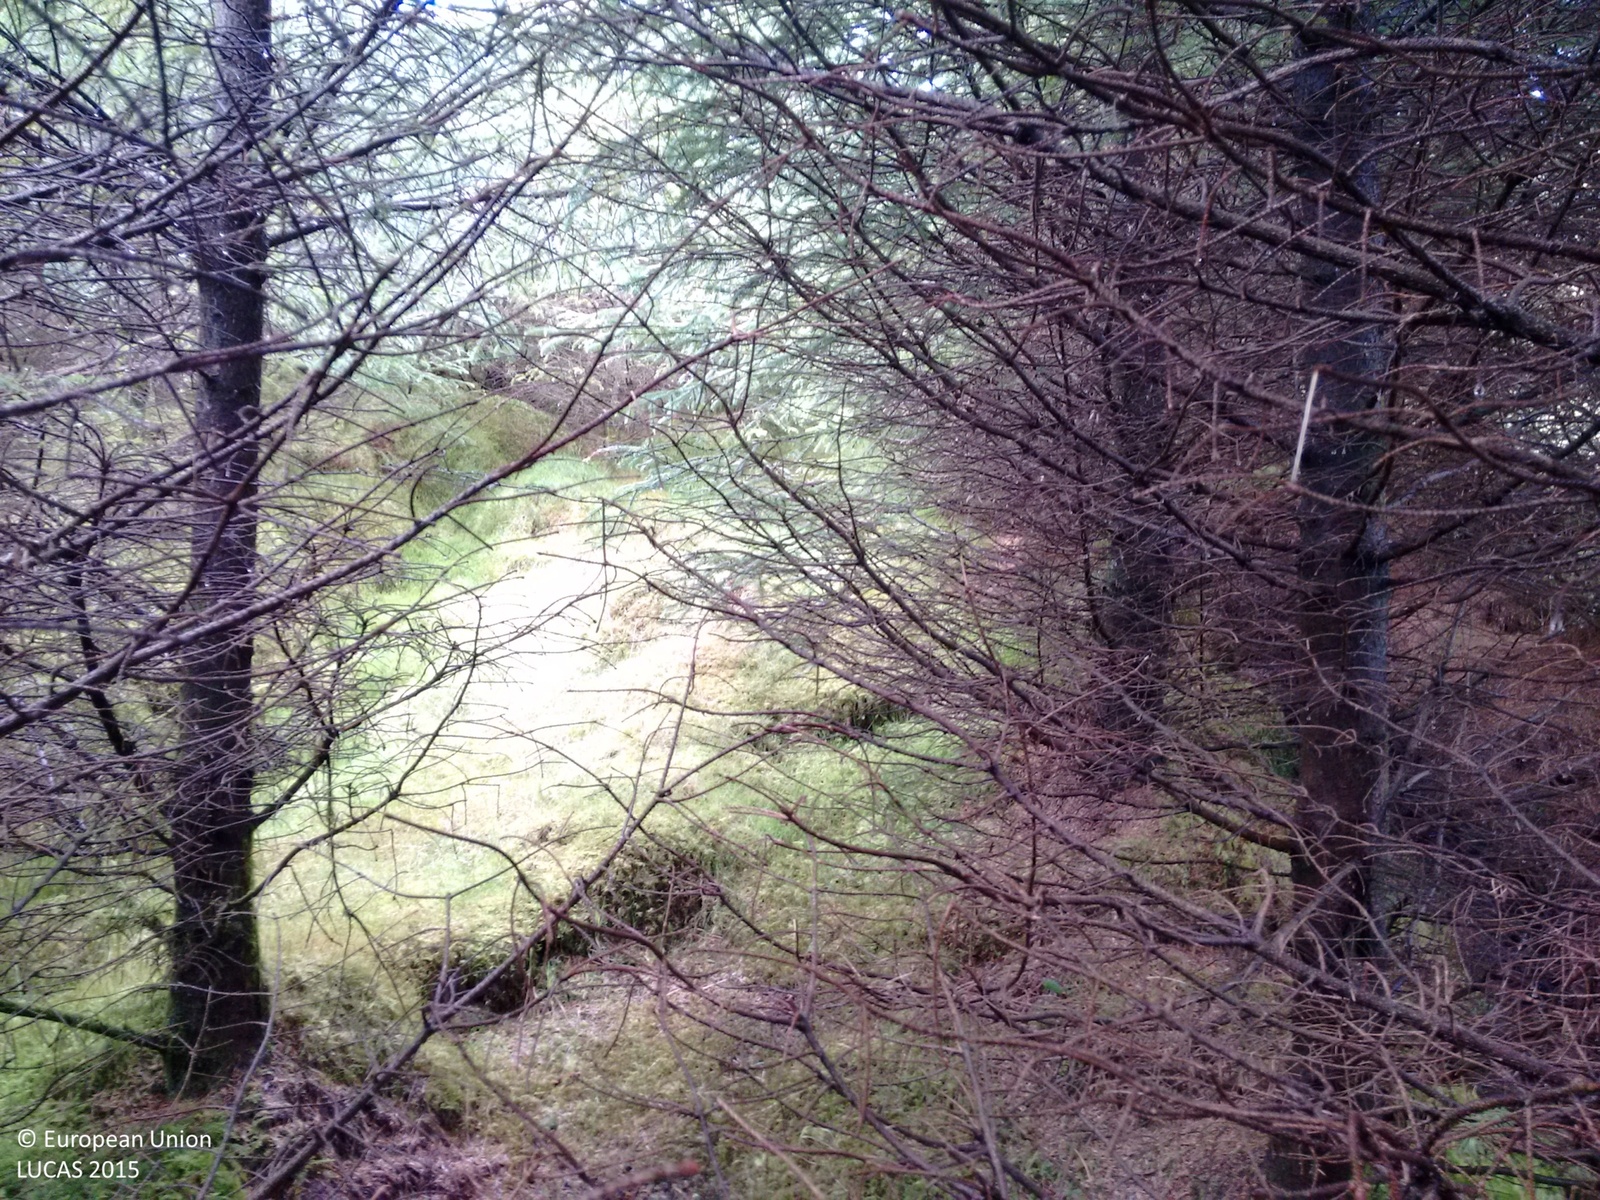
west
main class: Woodland
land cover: Spruce dominated coniferous woodland
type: exotic forest
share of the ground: > 75 %
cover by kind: coniferous forest trees 100 %
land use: Forestry
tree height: > 5 m
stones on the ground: < 10 %
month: May
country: GB
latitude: 56.1098
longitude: -5.1152
